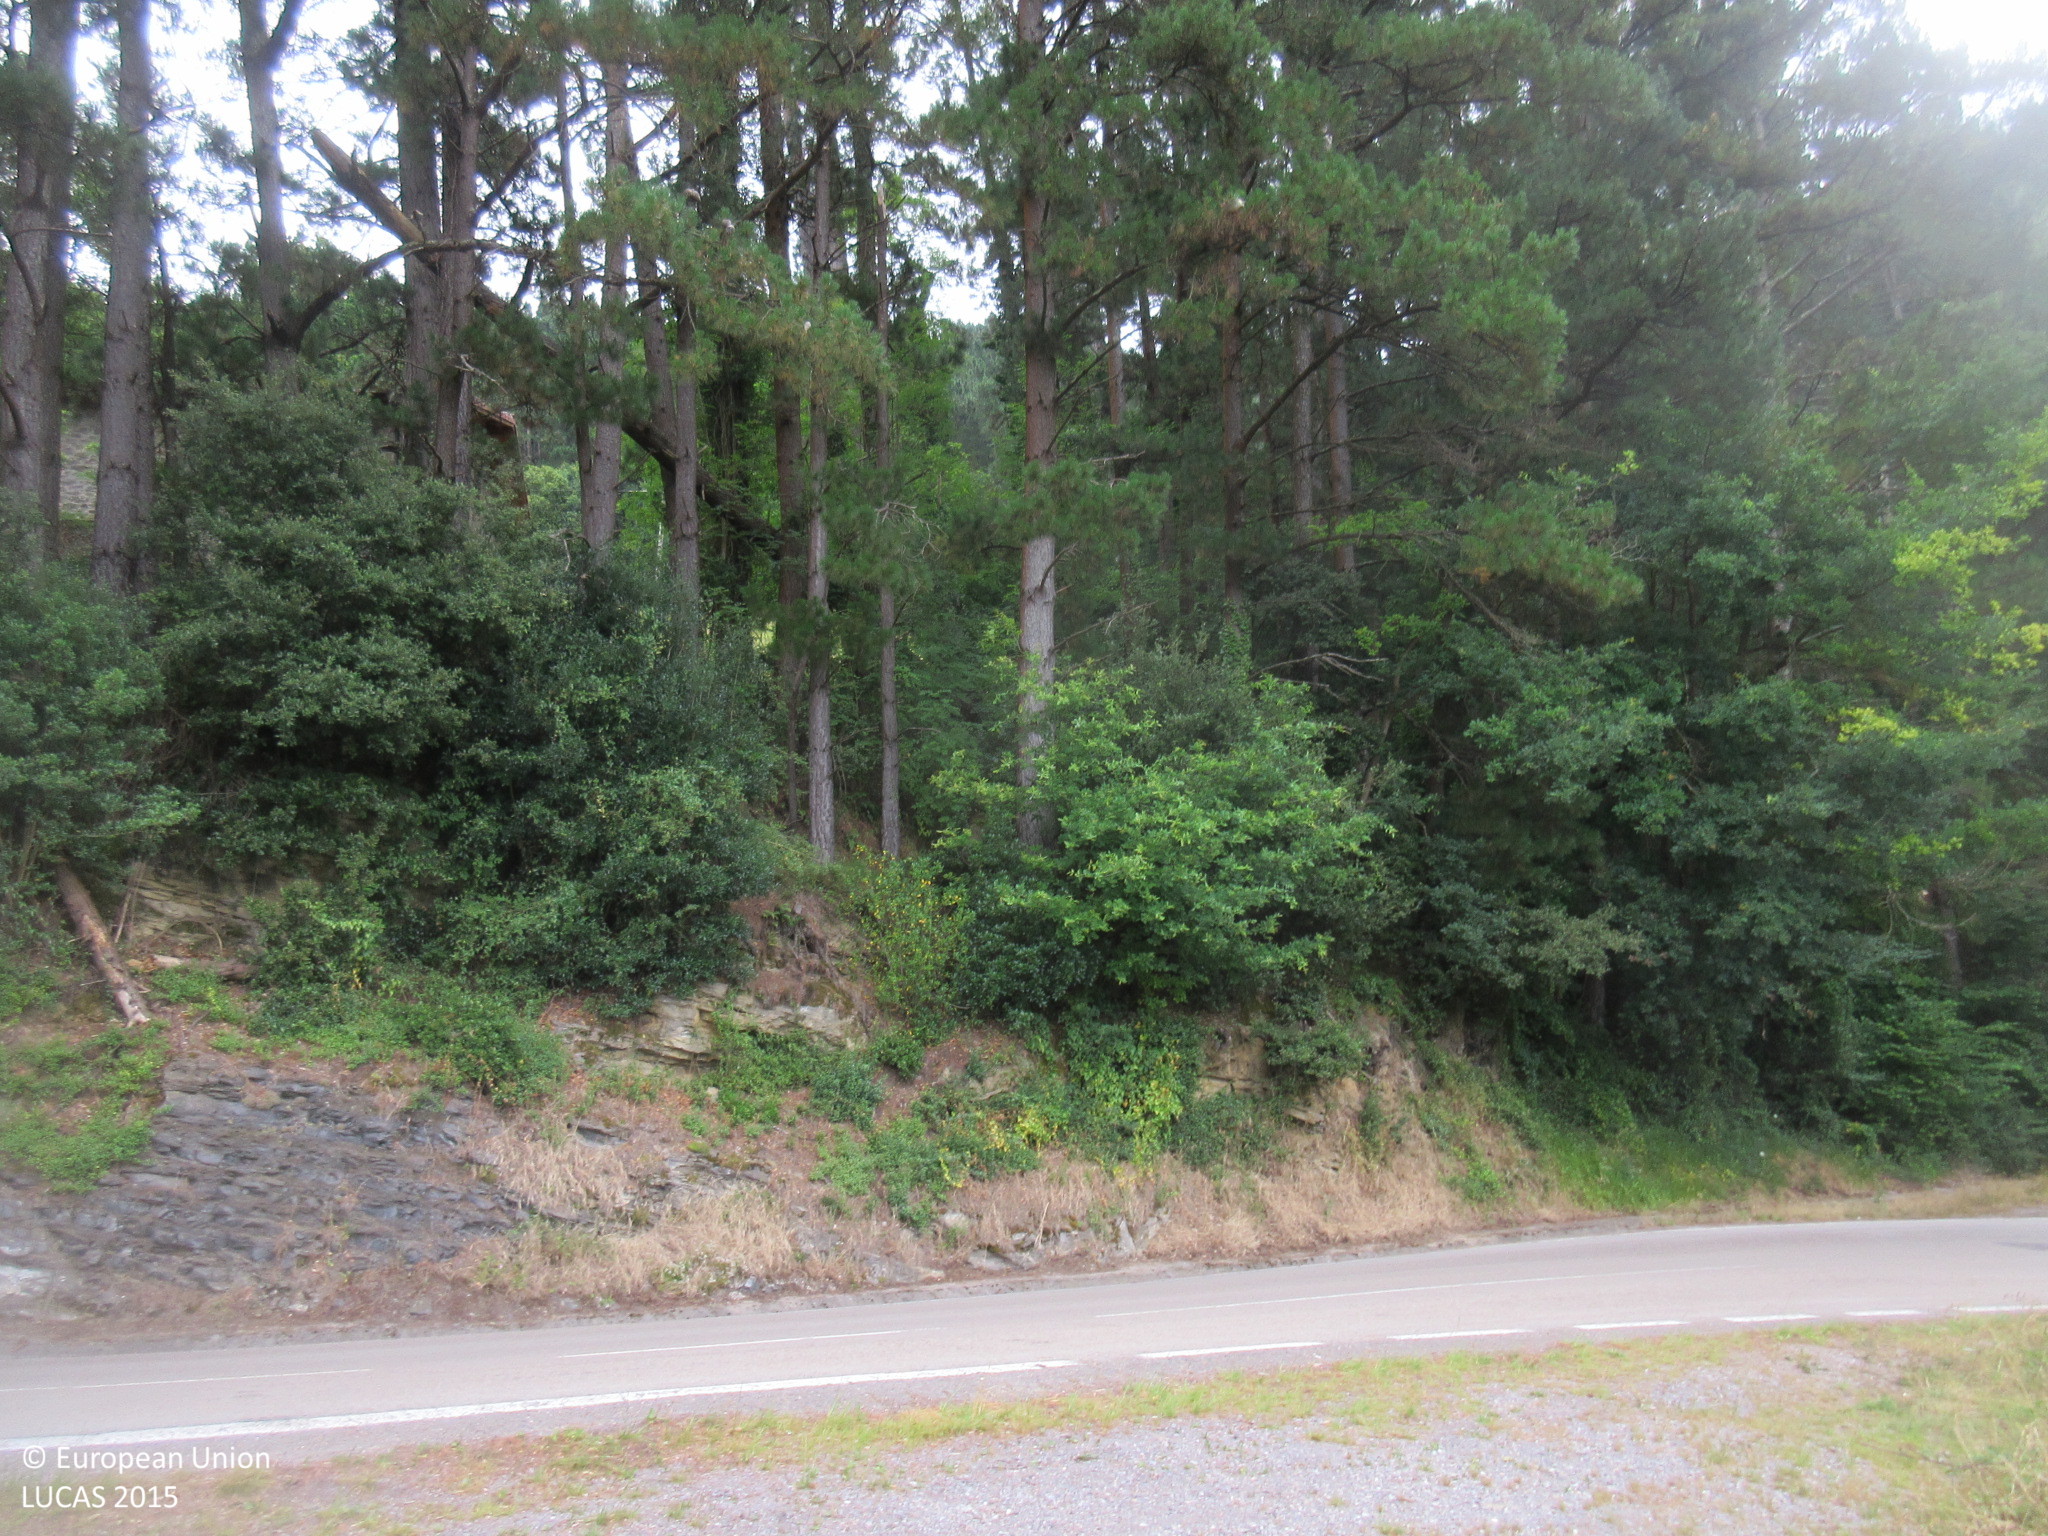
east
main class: Woodland
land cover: Broadleaved woodland
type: acidophilous oak and oak-birch forest
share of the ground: > 75 %
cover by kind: broadleaved forest trees 90 %, shrubs 10 %
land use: Semi-natural and natural areas not in use
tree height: > 5 m
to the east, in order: Broadleaved woodland; Shrubland with sparse tree cover; Paved roads, cycling and walking lanes; Broadleaved woodland; Pine dominated coniferous woodland
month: July
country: ES
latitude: 43.2118
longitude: -3.4707
